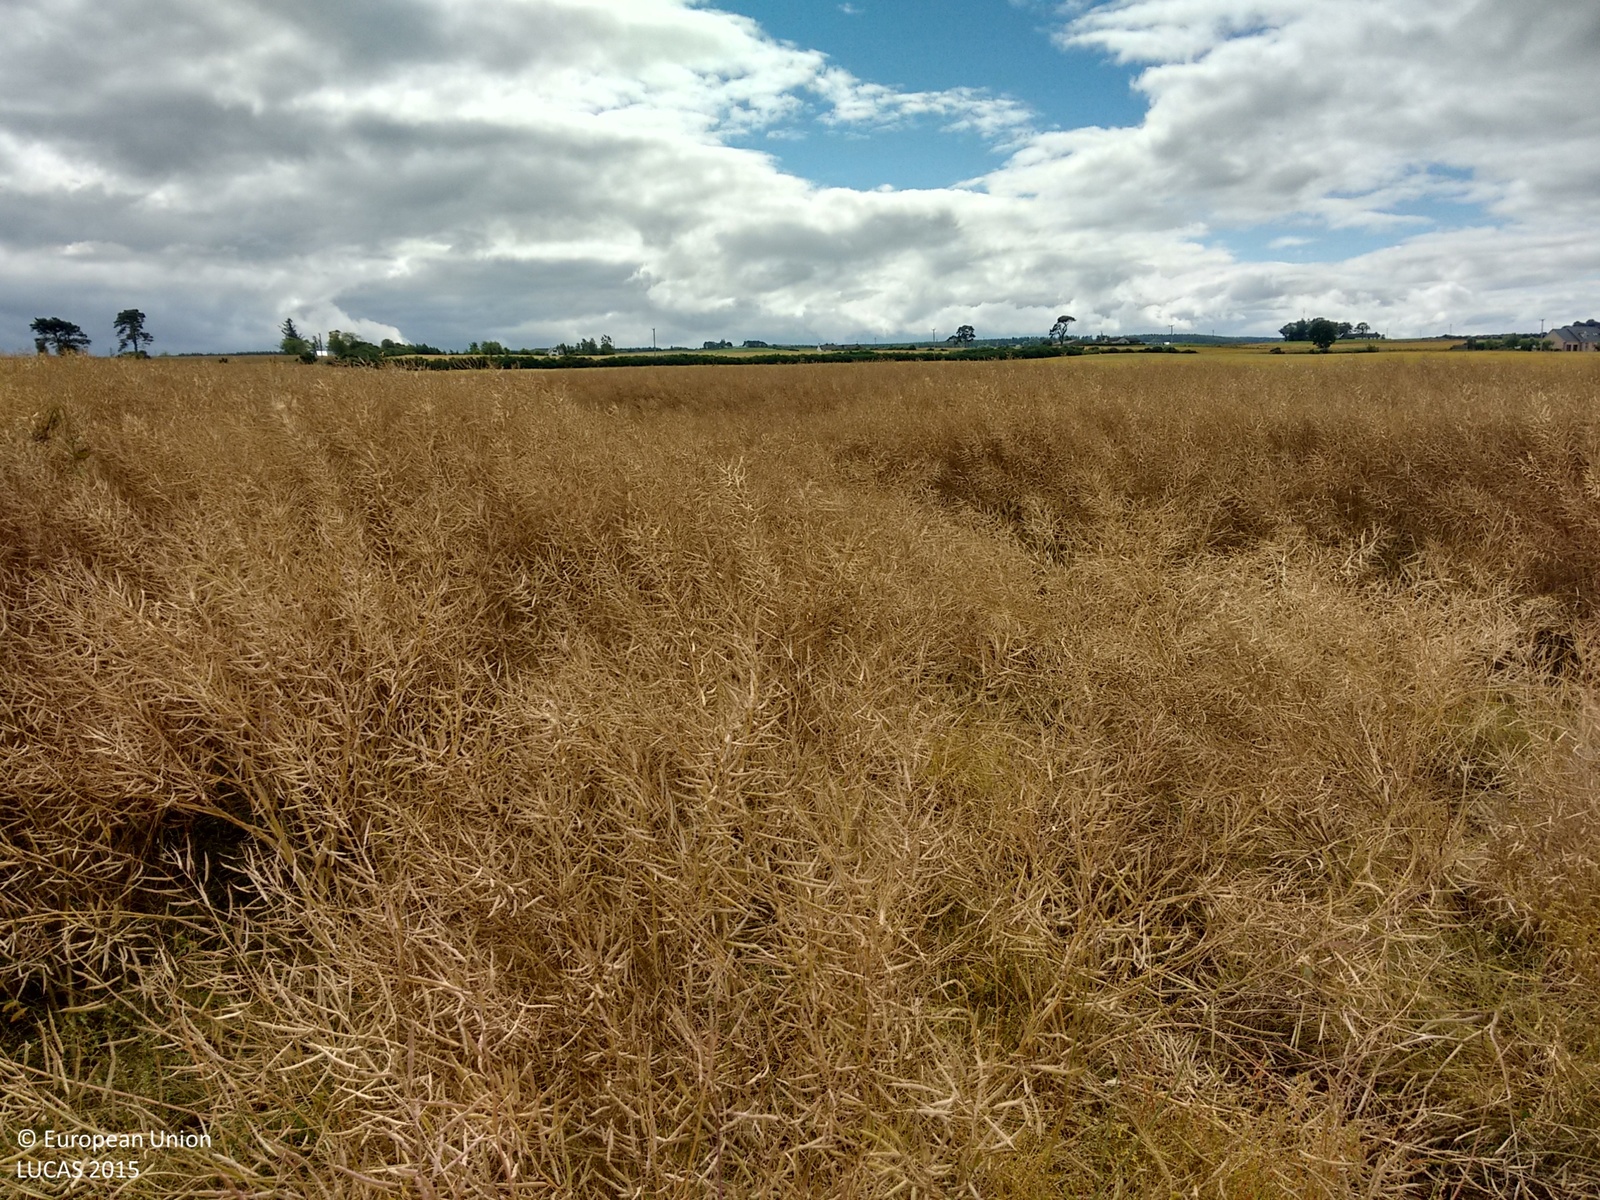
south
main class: Cropland
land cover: Rape and turnip rape
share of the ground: > 75 %
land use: Agriculture (excluding fallow land and kitchen gardens)
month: August
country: GB
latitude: 57.6565
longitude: -4.2460
